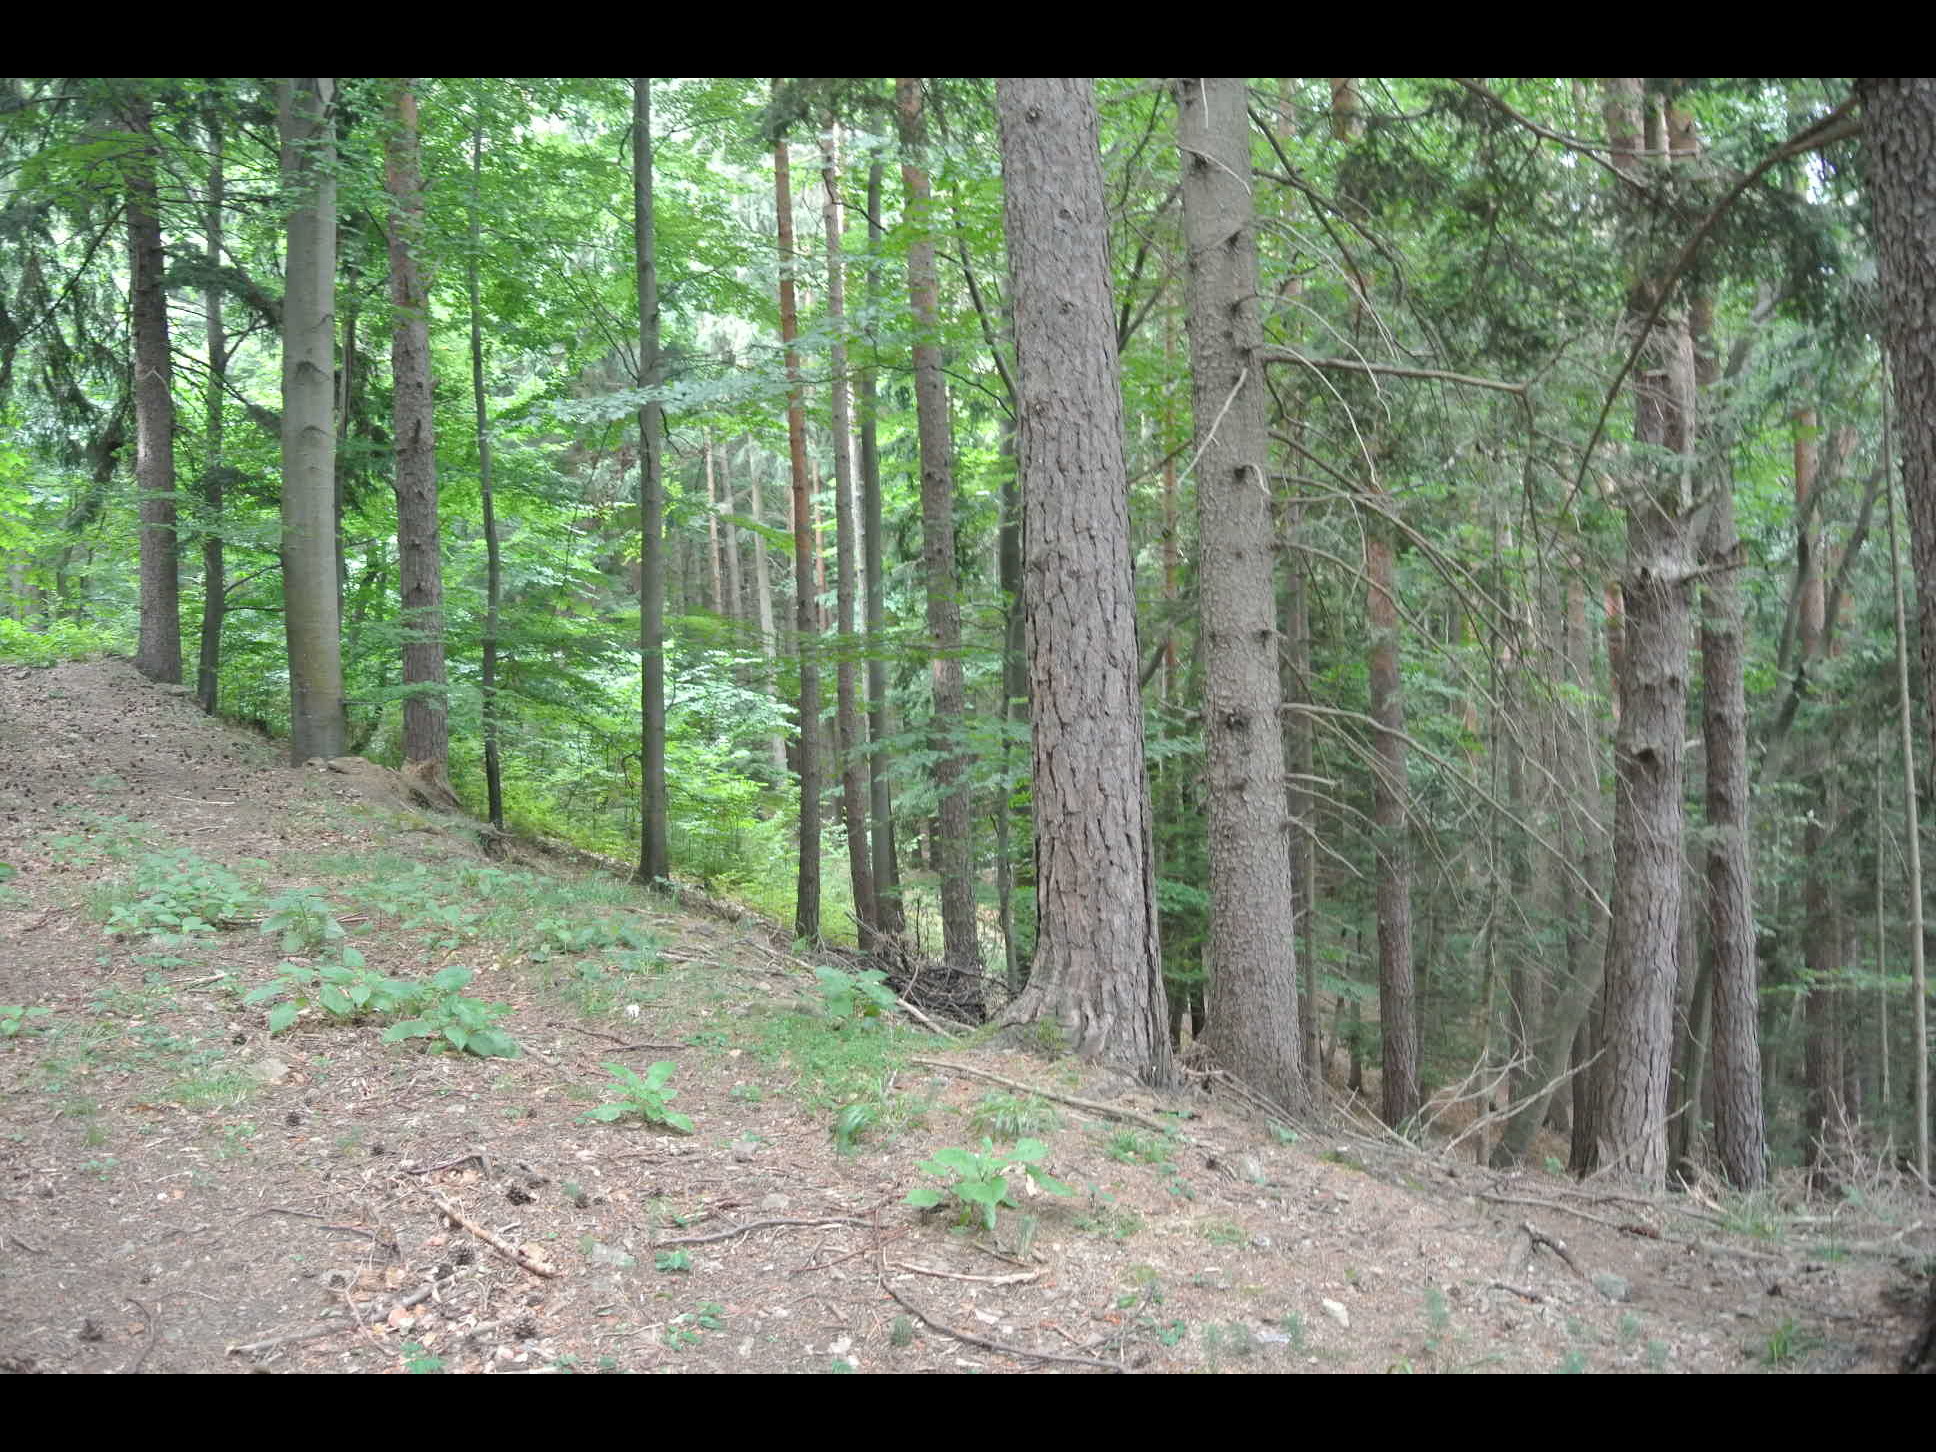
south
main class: Woodland
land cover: Other mixed woodland
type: alpine coniferous forest
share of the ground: > 75 %
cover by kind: coniferous forest trees 60 %, broadleaved forest trees 40 %
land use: Forestry
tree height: > 5 m
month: July
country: AT
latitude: 47.6732
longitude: 16.1431
